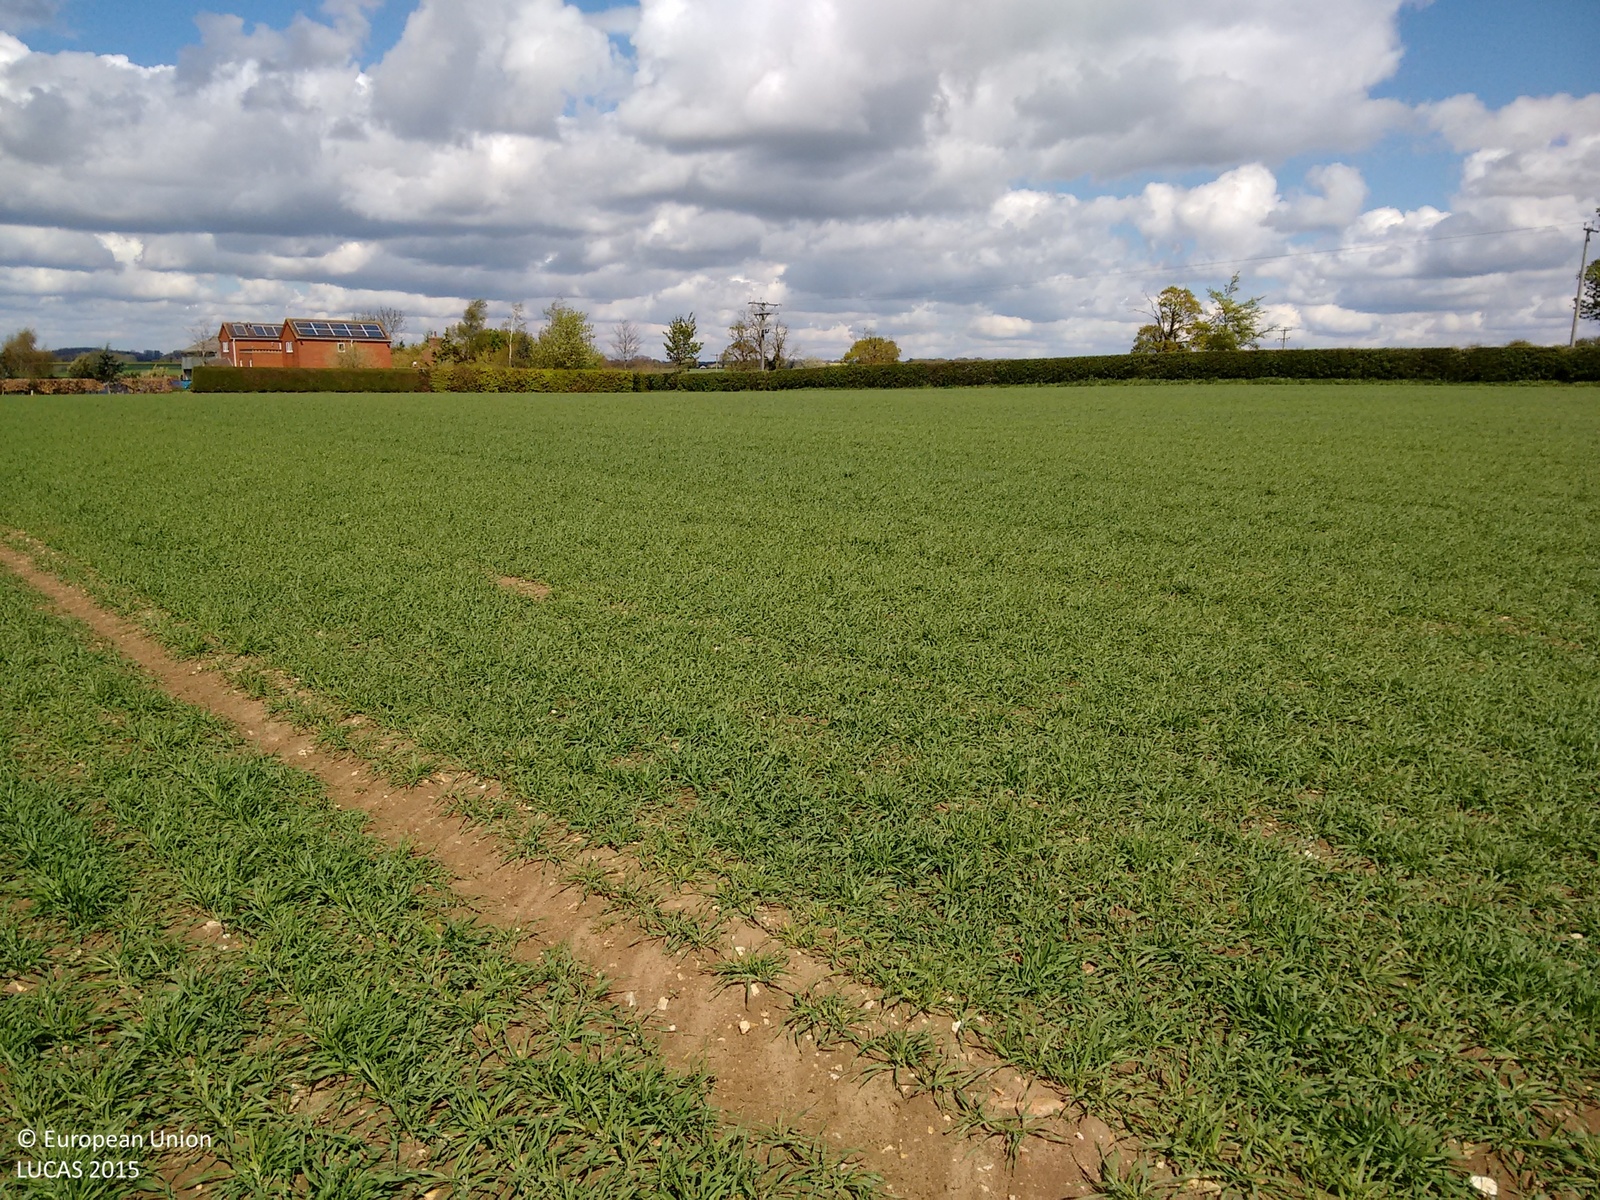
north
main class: Cropland
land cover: Barley
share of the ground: 50 - 75 %
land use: Agriculture (excluding fallow land and kitchen gardens)
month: April
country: GB
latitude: 53.1422
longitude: -0.0943
